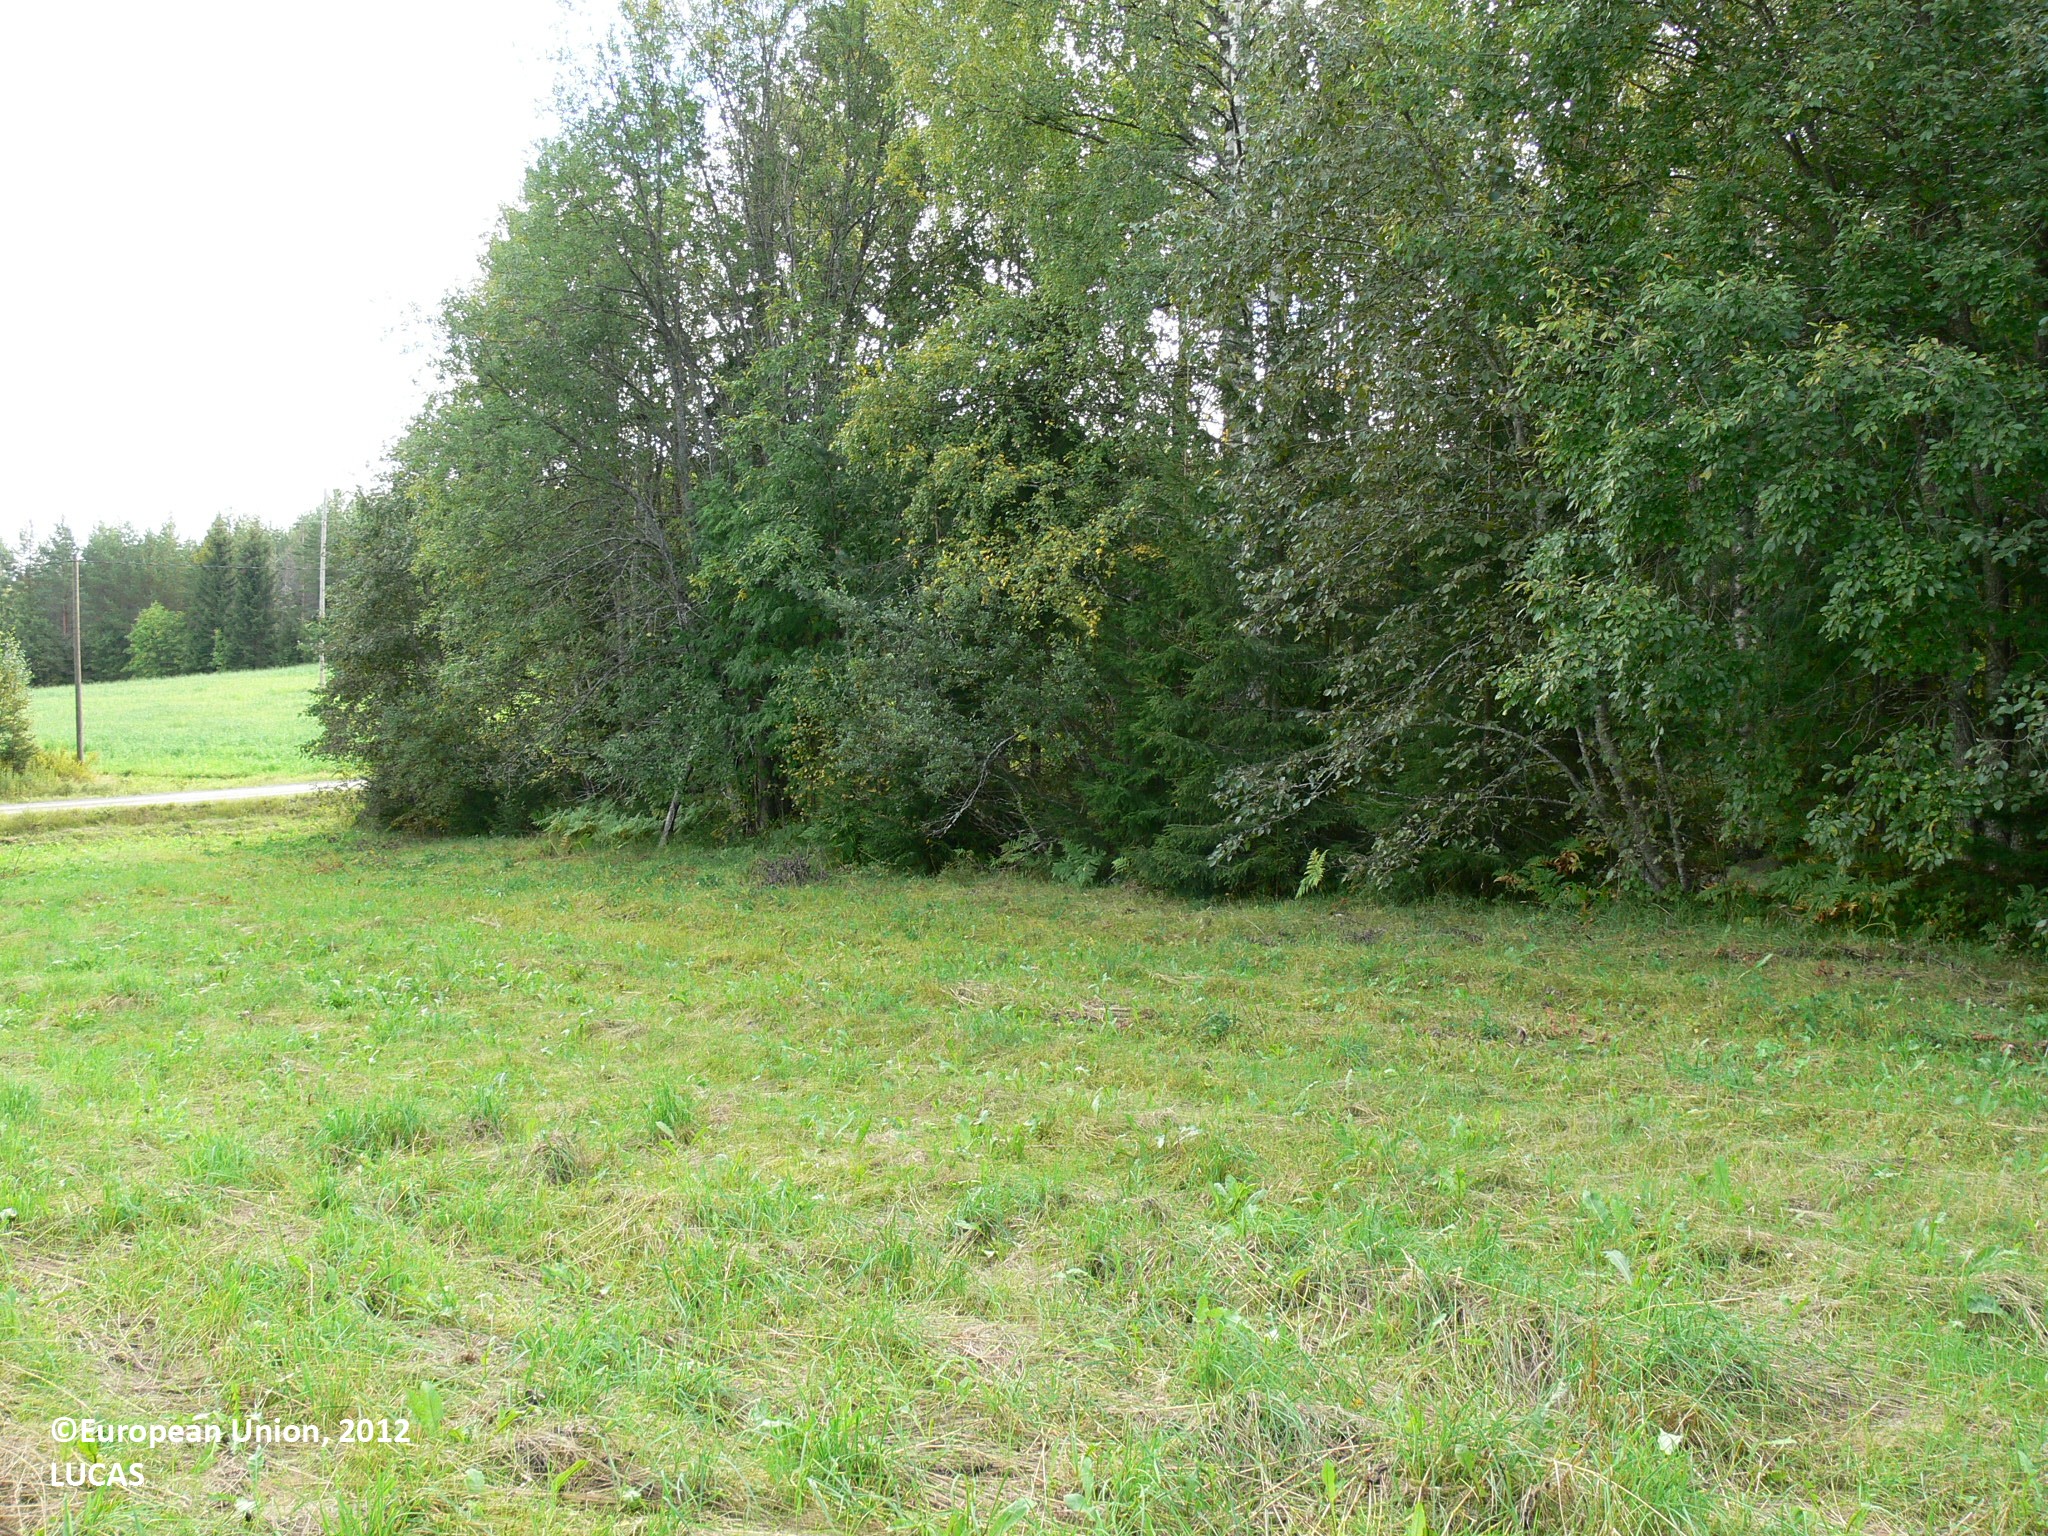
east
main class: Cropland
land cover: Temporary grasslands
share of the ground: 50 - 75 %
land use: Agriculture (excluding fallow land and kitchen gardens)
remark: Harvested field
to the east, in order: Temporary grasslands; Grass margins; Paved roads, cycling and walking lanes; Grass margins; Ditches and canals; Grass margins; Electric lines; Grass margins; Temporary grasslands; Electric lines; Temporary grasslands; Grass margins; Other mixed woodland; Pine dominated coniferous woodland; Other mixed woodland
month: August
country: FI
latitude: 62.0348
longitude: 30.2527
